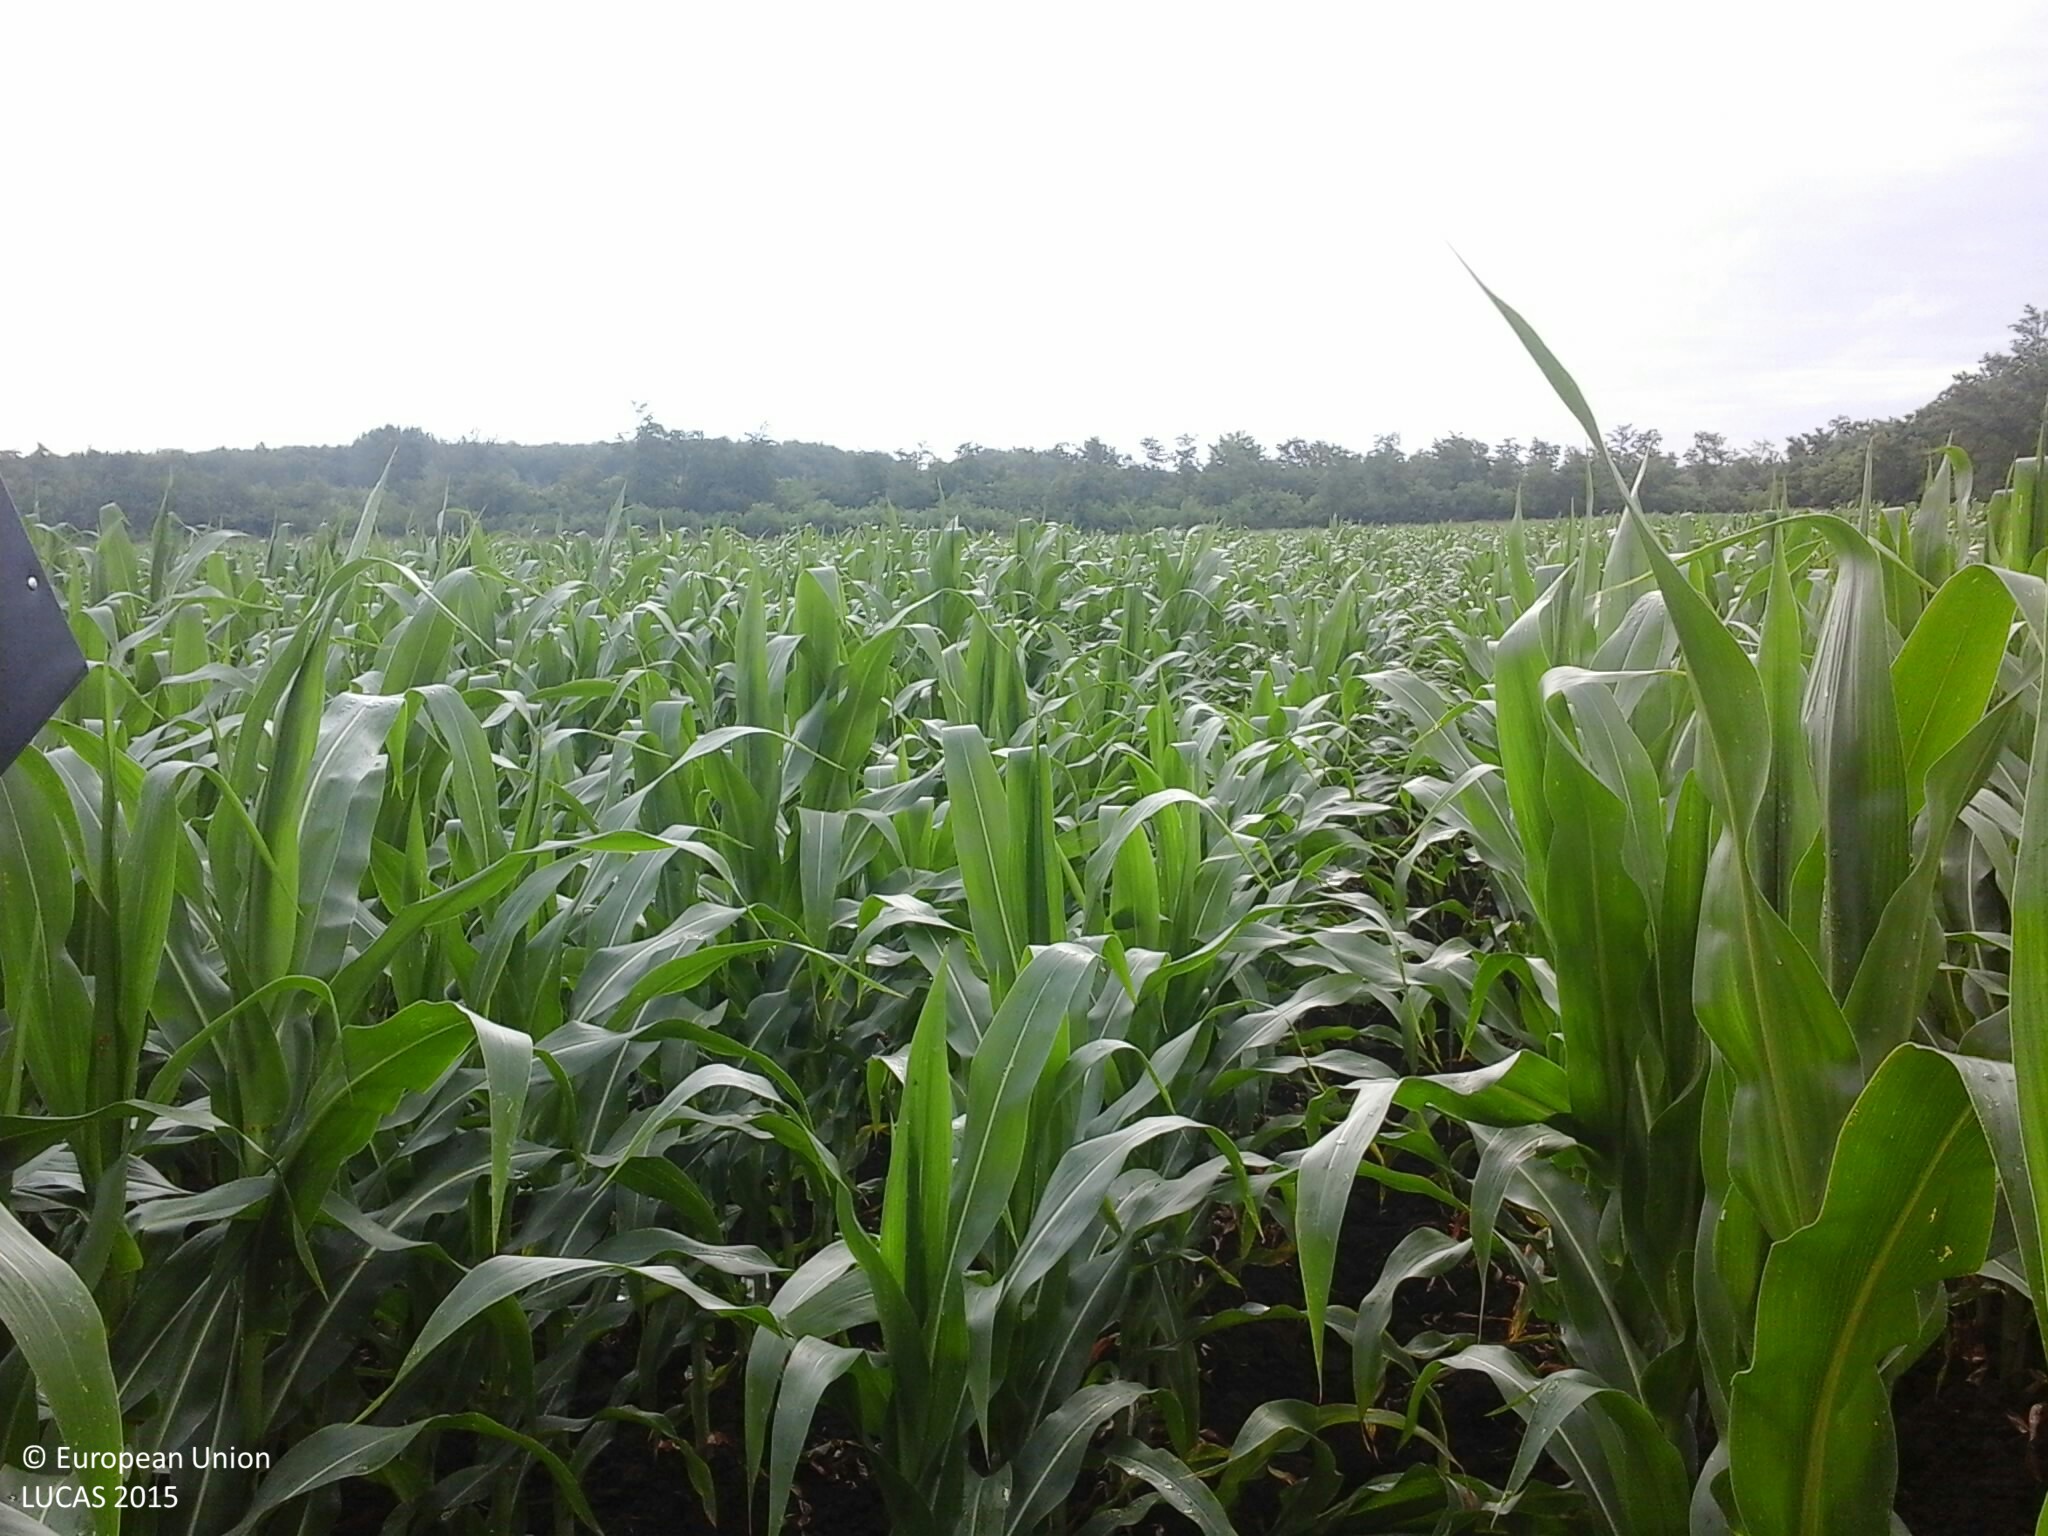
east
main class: Cropland
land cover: Maize
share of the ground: > 75 %
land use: Agriculture (excluding fallow land and kitchen gardens)
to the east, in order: Maize; Other fresh vegetables; Spontaneously vegetated surfaces; Broadleaved woodland; Tracks; Broadleaved woodland
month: July
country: HU
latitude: 47.7898
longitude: 21.9439
